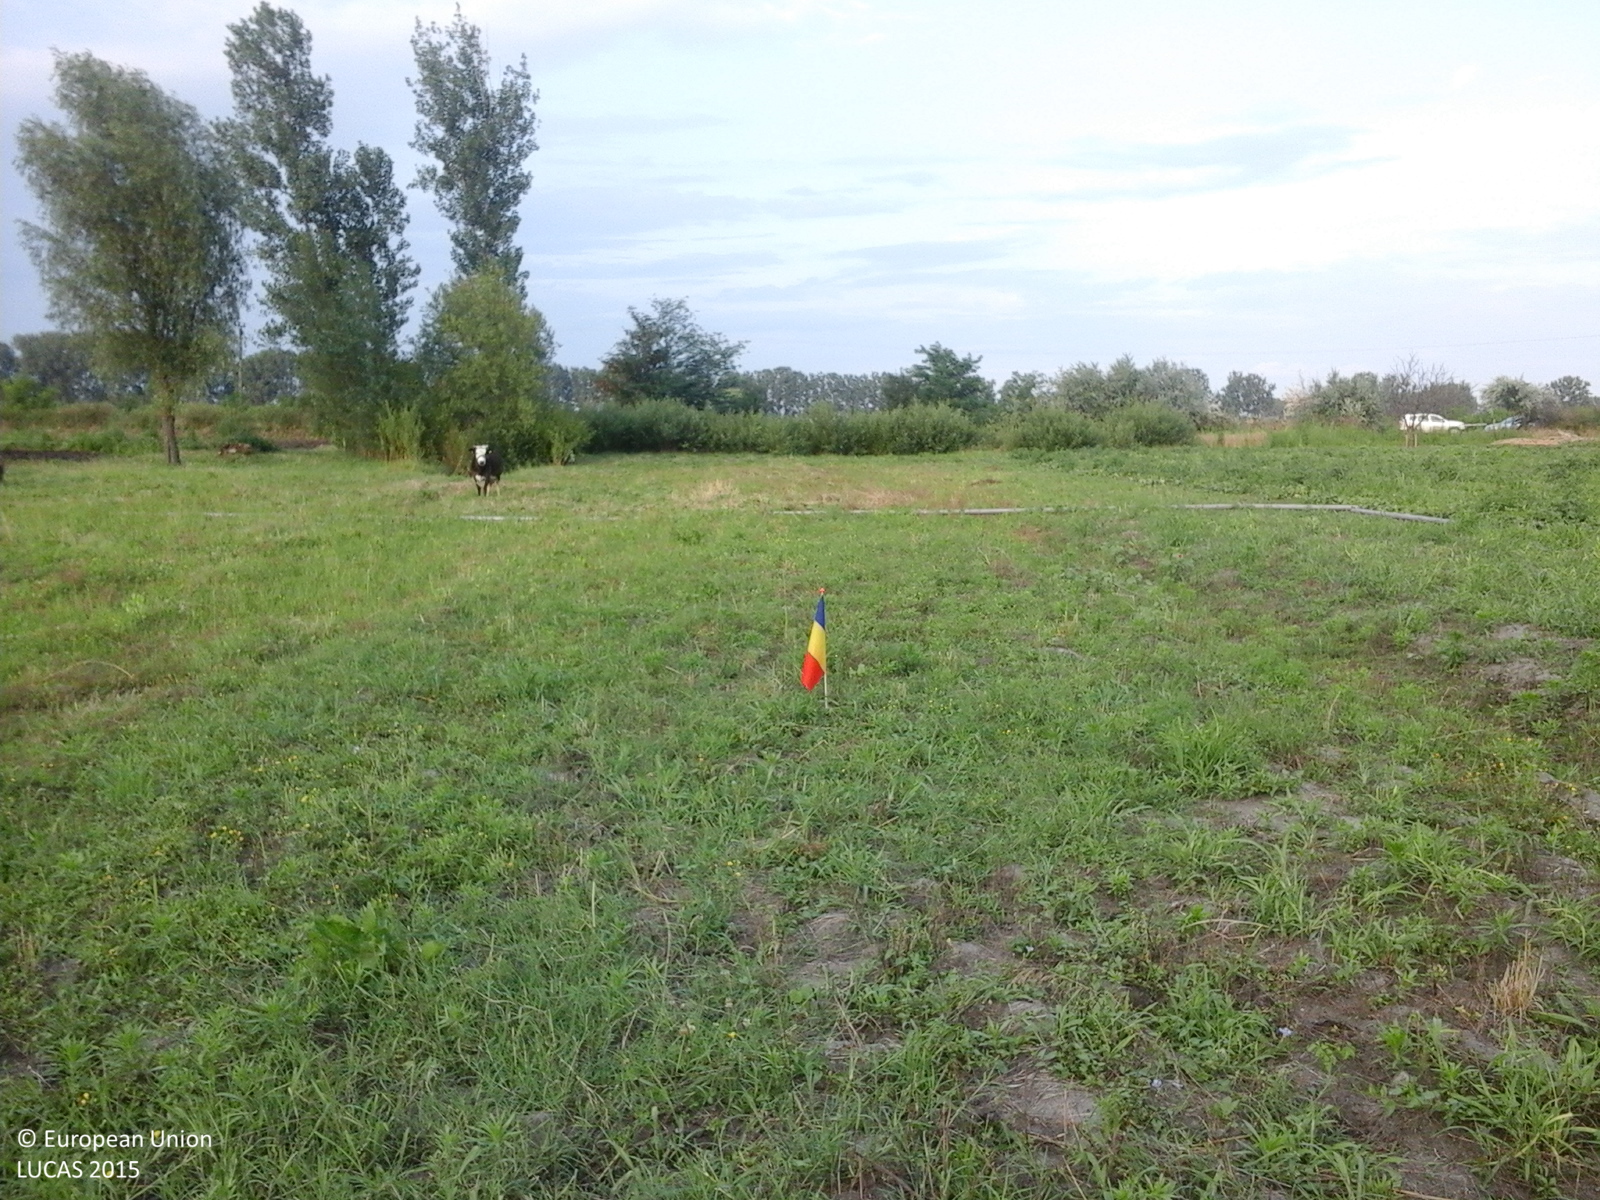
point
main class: Grassland
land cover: Grassland without tree/shrub cover
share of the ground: > 75 %
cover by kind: herbaceous plants 100 %
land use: Agriculture (excluding fallow land and kitchen gardens)
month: July
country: RO
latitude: 43.7898
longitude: 24.0619
